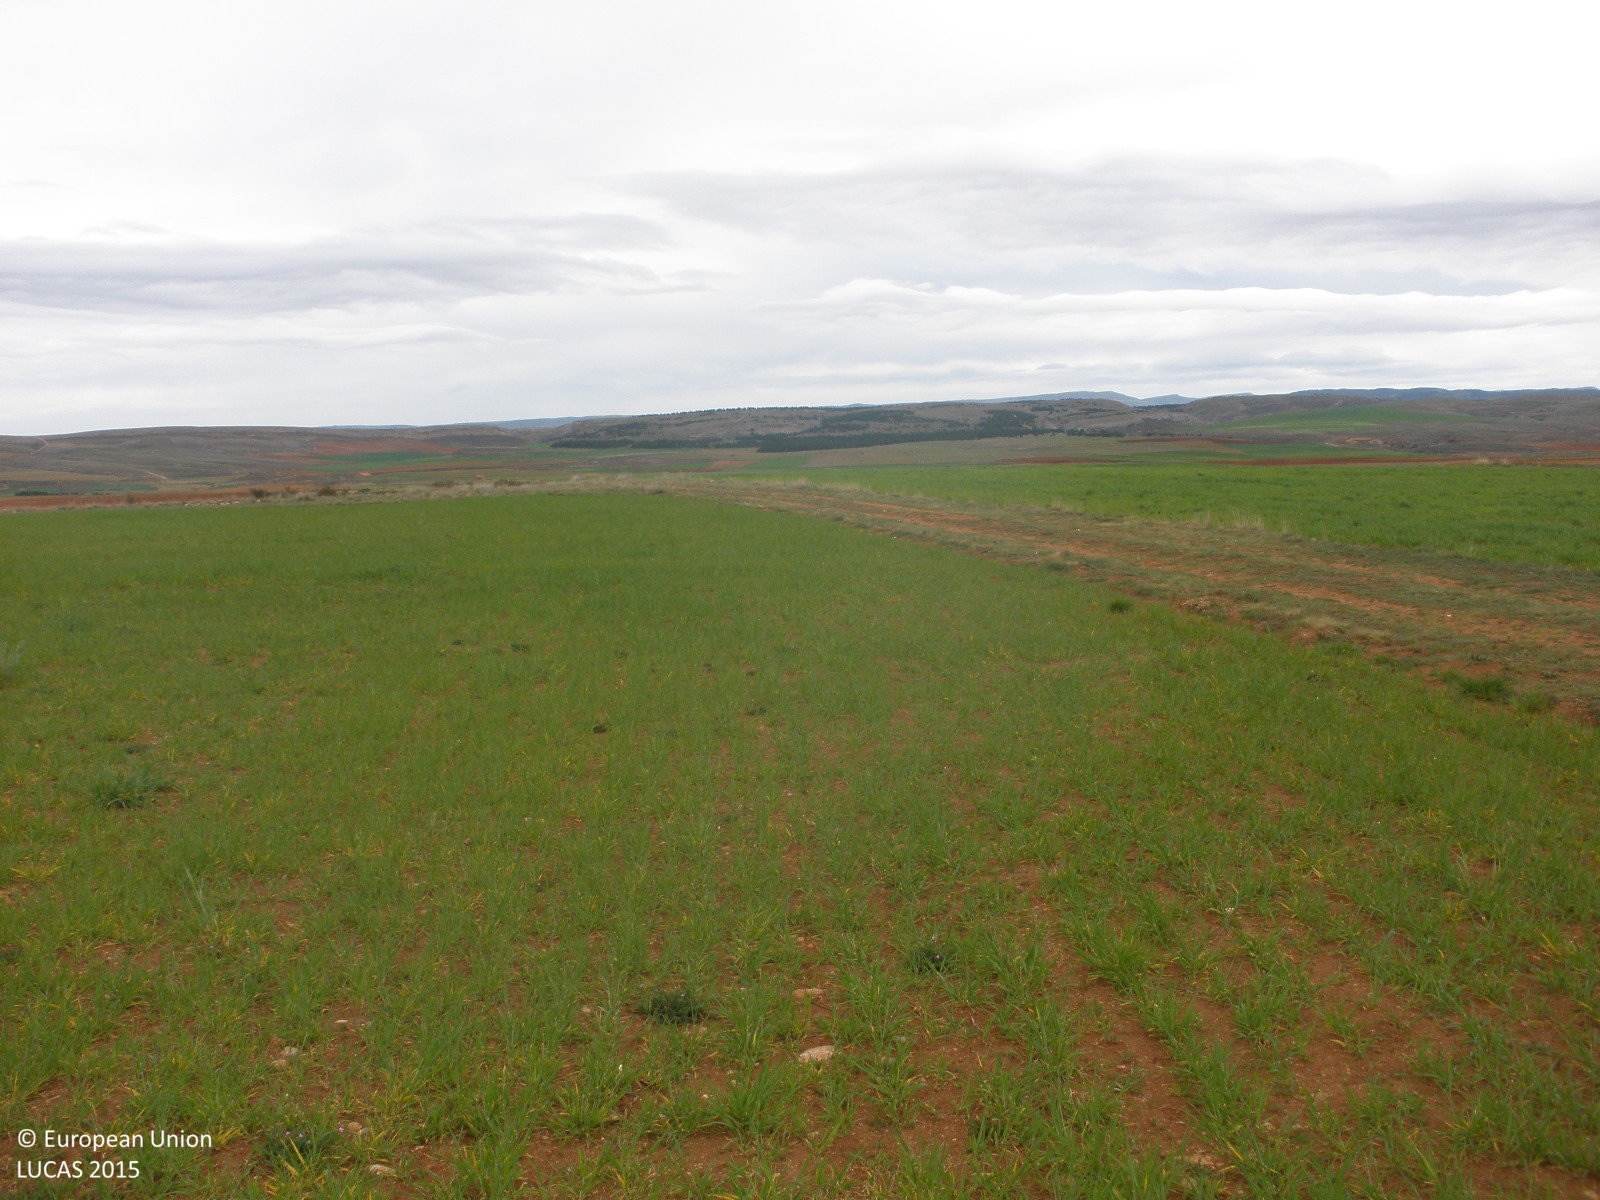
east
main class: Cropland
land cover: Barley
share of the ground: 50 - 75 %
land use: Agriculture (excluding fallow land and kitchen gardens)
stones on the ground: 10 - 25 %
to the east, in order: Barley; Shrubland without tree cover; Tracks; Shrubland without tree cover; Common wheat; Grass margins; Other bare soil
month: May
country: ES
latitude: 40.5226
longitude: -0.8346
